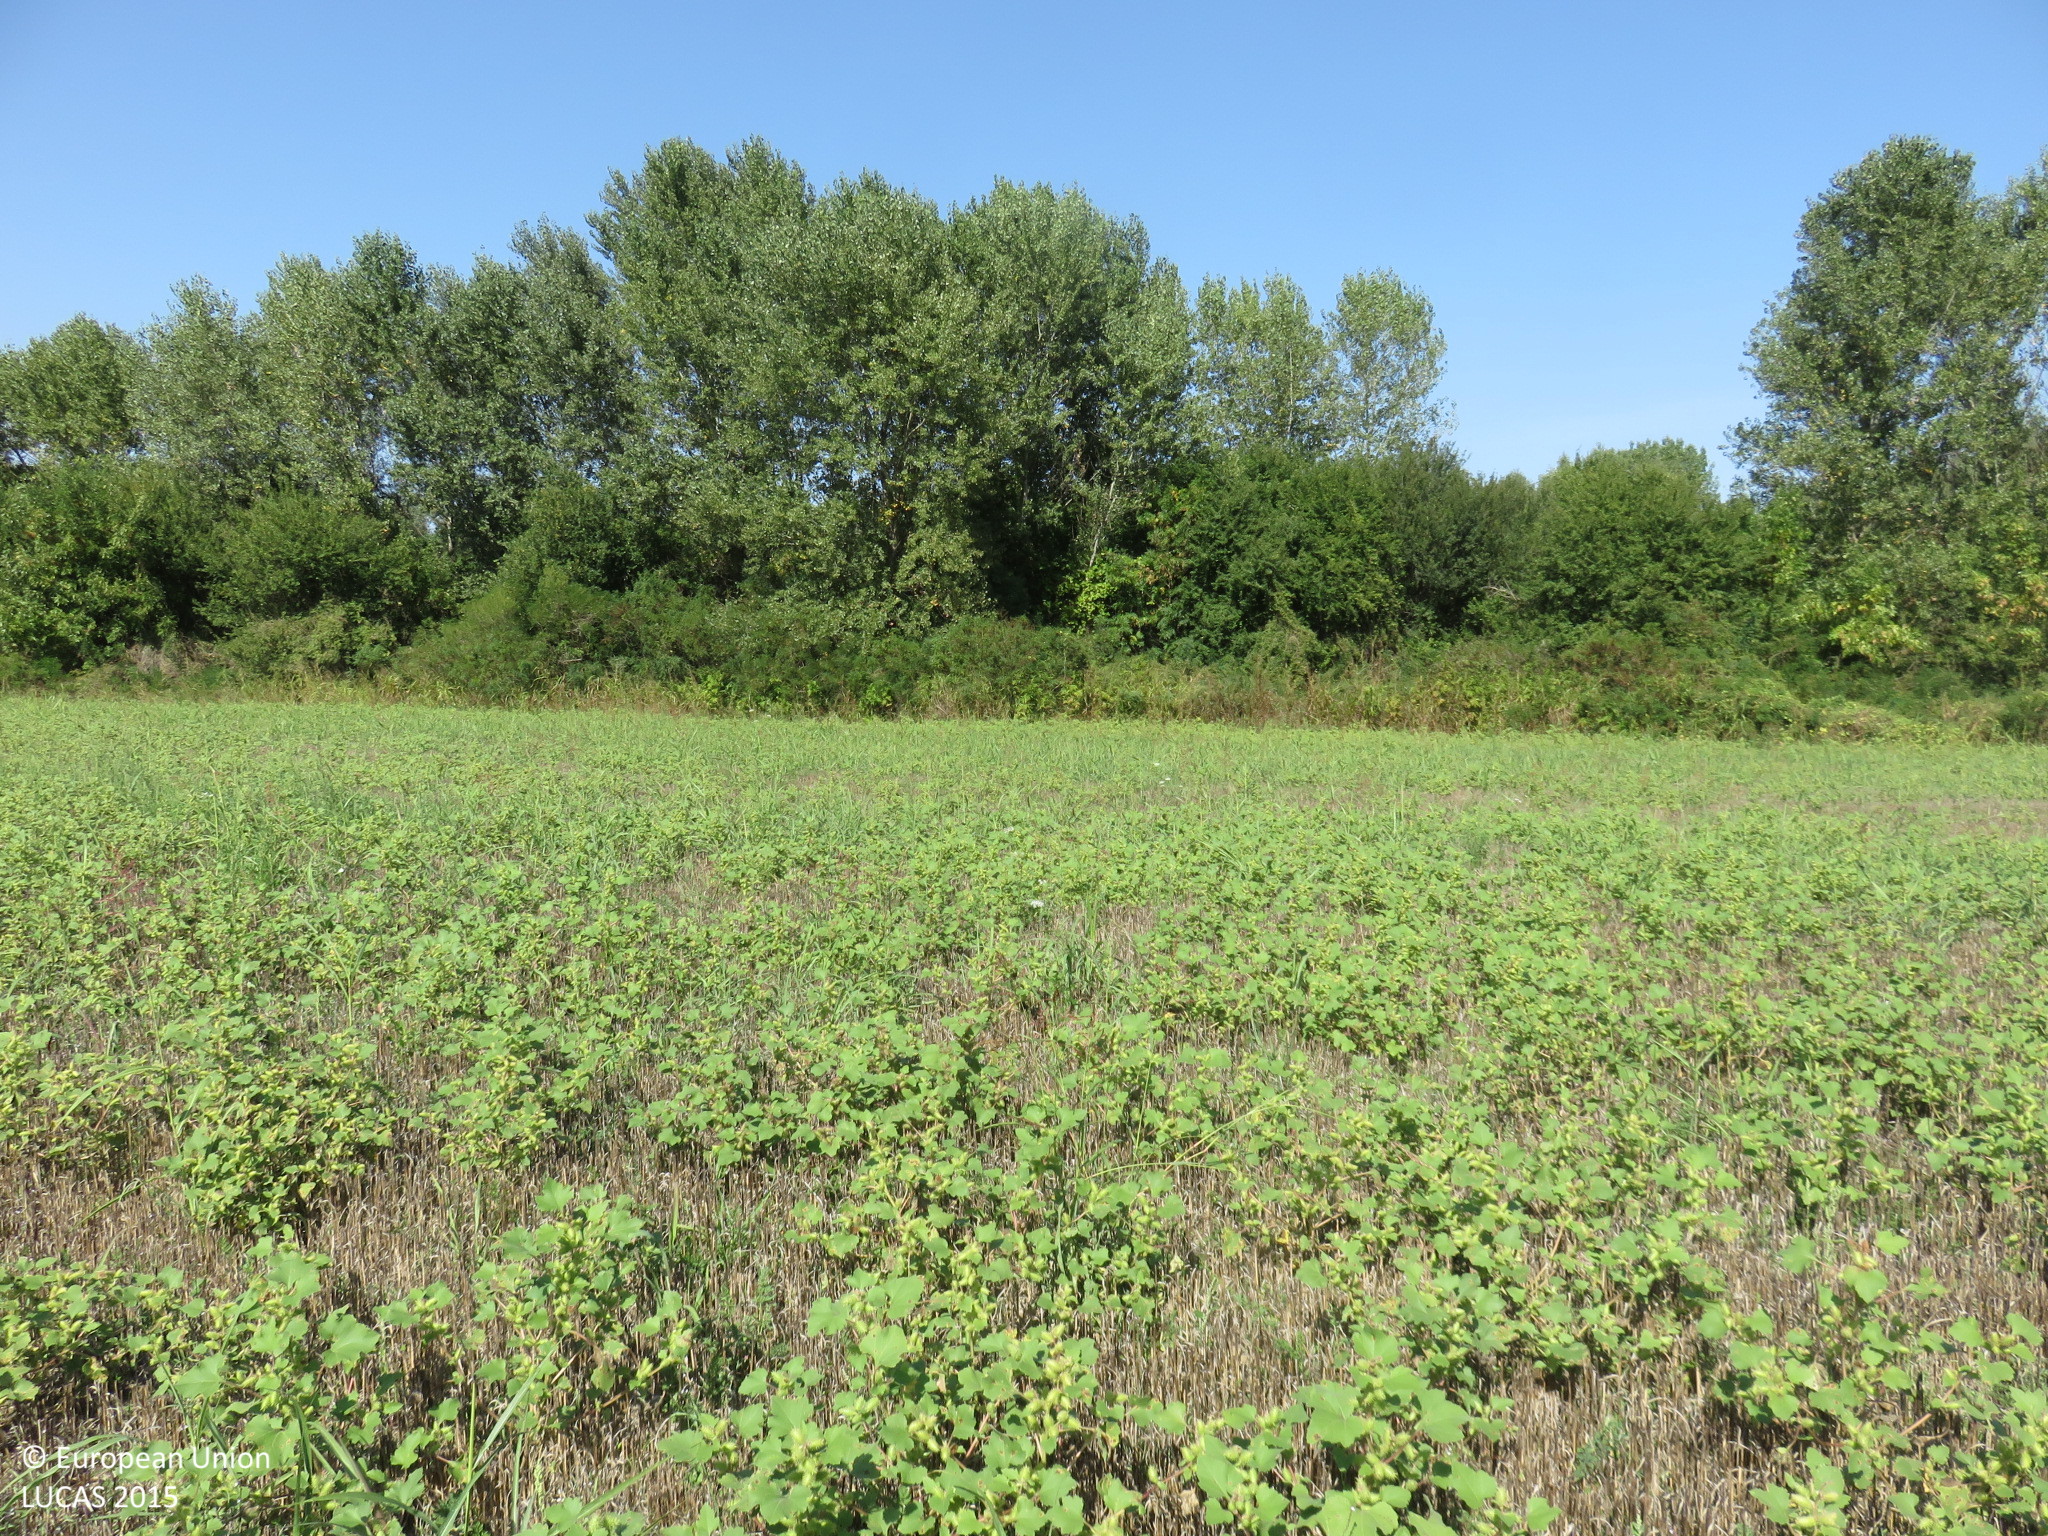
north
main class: Cropland
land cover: Common wheat
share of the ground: 25 - 50 %
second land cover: Spontaneously vegetated surfaces
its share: 50 - 75 %
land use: Agriculture (excluding fallow land and kitchen gardens)
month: September
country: BG
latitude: 43.7037
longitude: 24.6726
